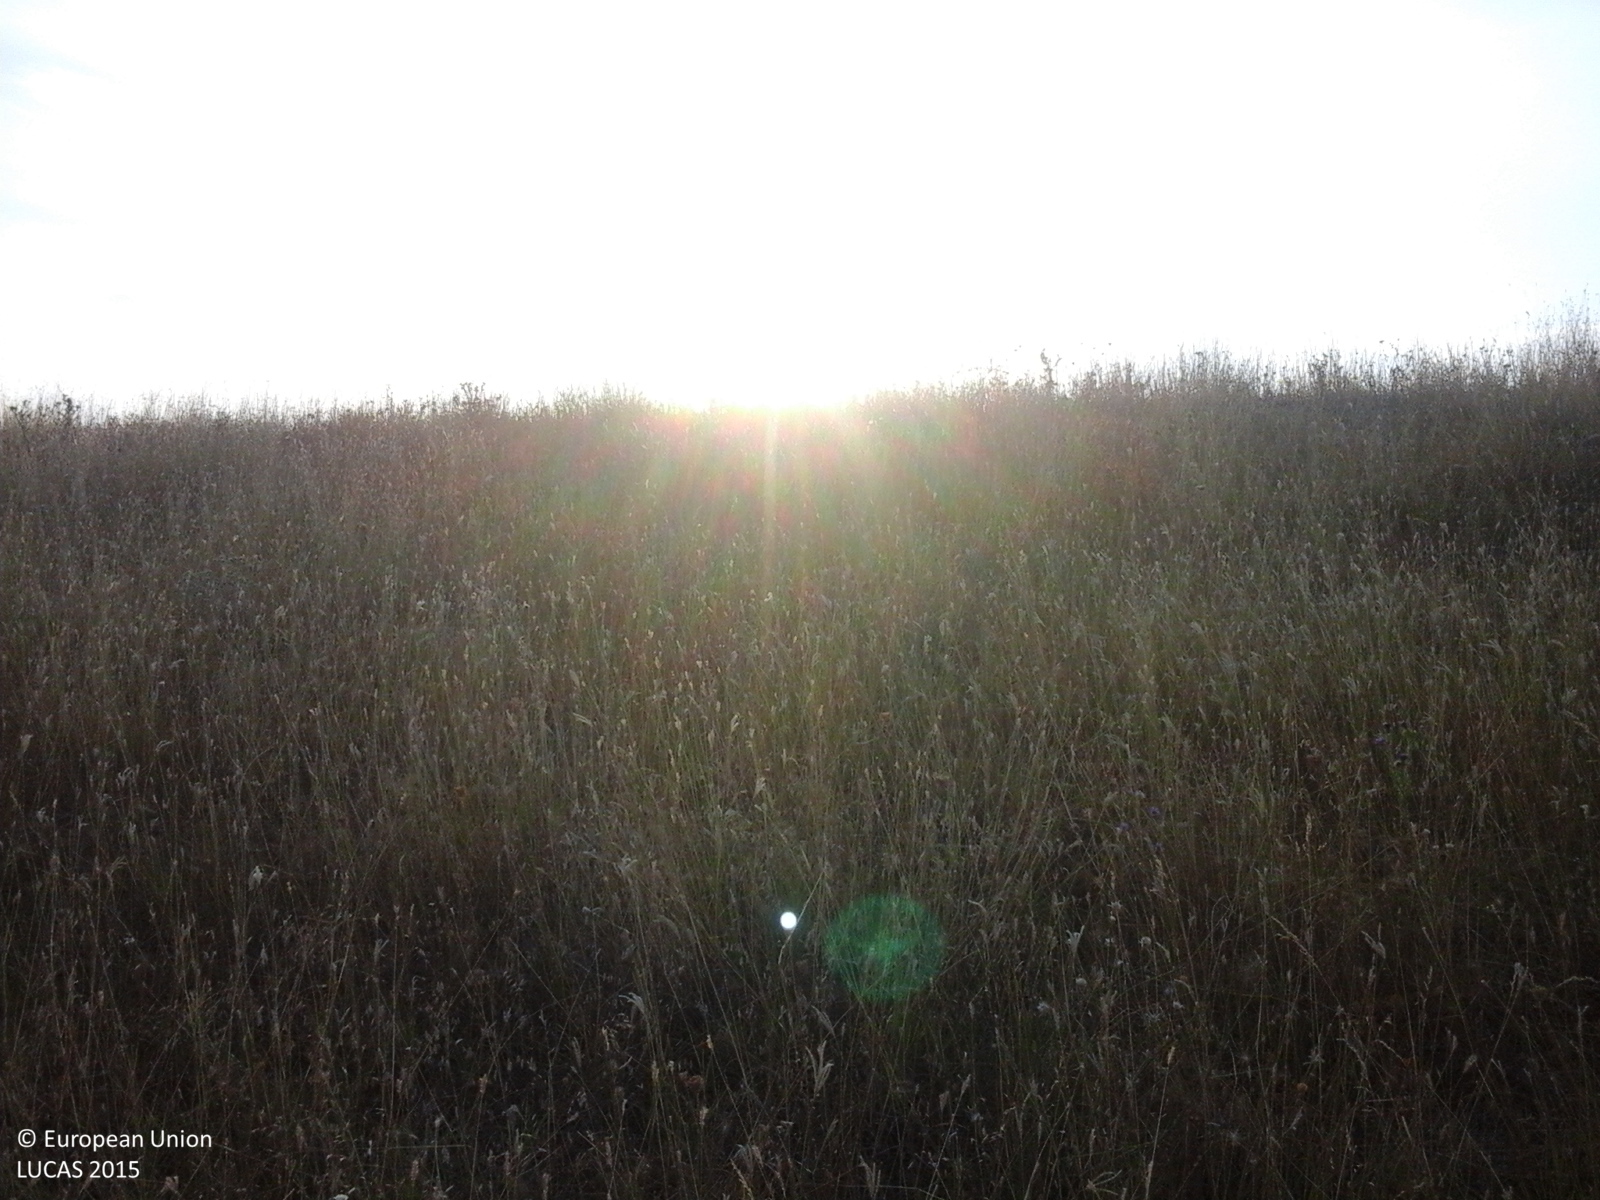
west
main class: Grassland
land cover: Grassland without tree/shrub cover
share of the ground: > 75 %
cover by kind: herbaceous plants 100 %
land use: Agriculture (excluding fallow land and kitchen gardens)
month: August
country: RO
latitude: 44.2662
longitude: 23.0855
